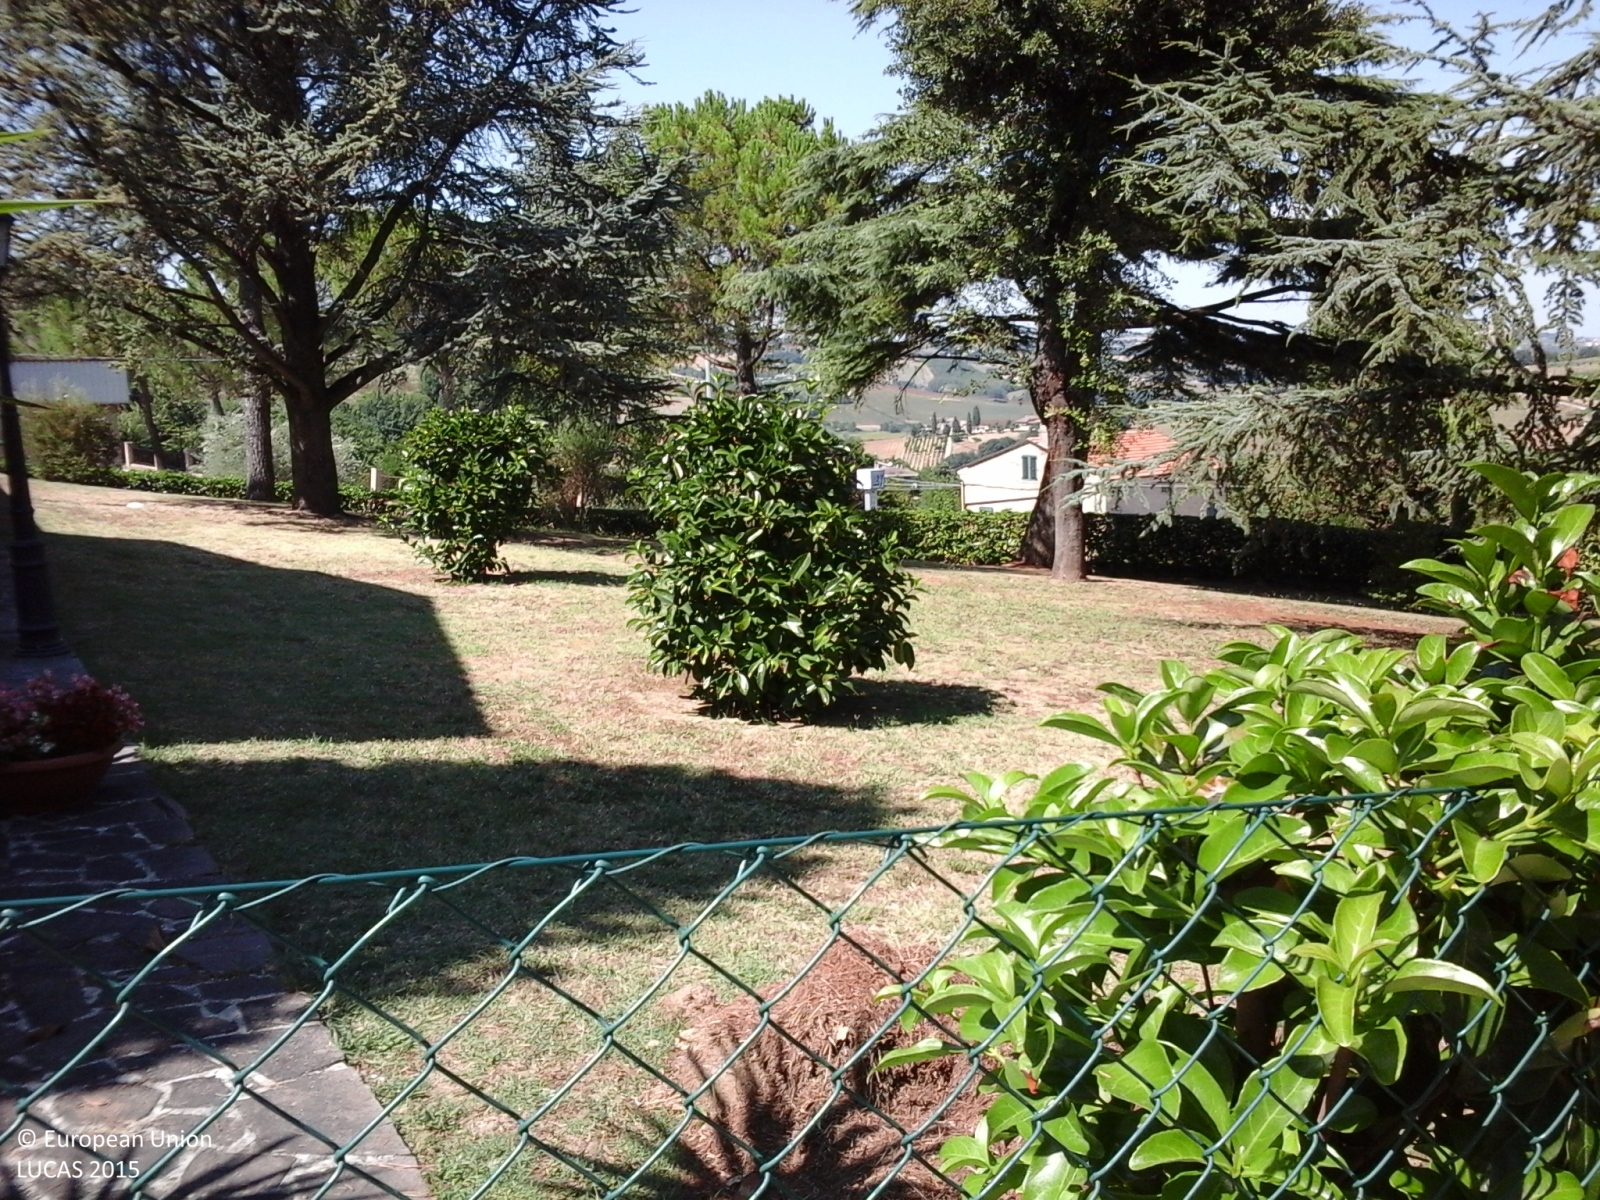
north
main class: Woodland
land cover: Other coniferous woodland
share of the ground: 50 - 75 %
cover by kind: coniferous forest trees 70 %, herbaceous plants 30 %
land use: Residential
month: August
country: IT
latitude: 43.1908
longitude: 13.4732
